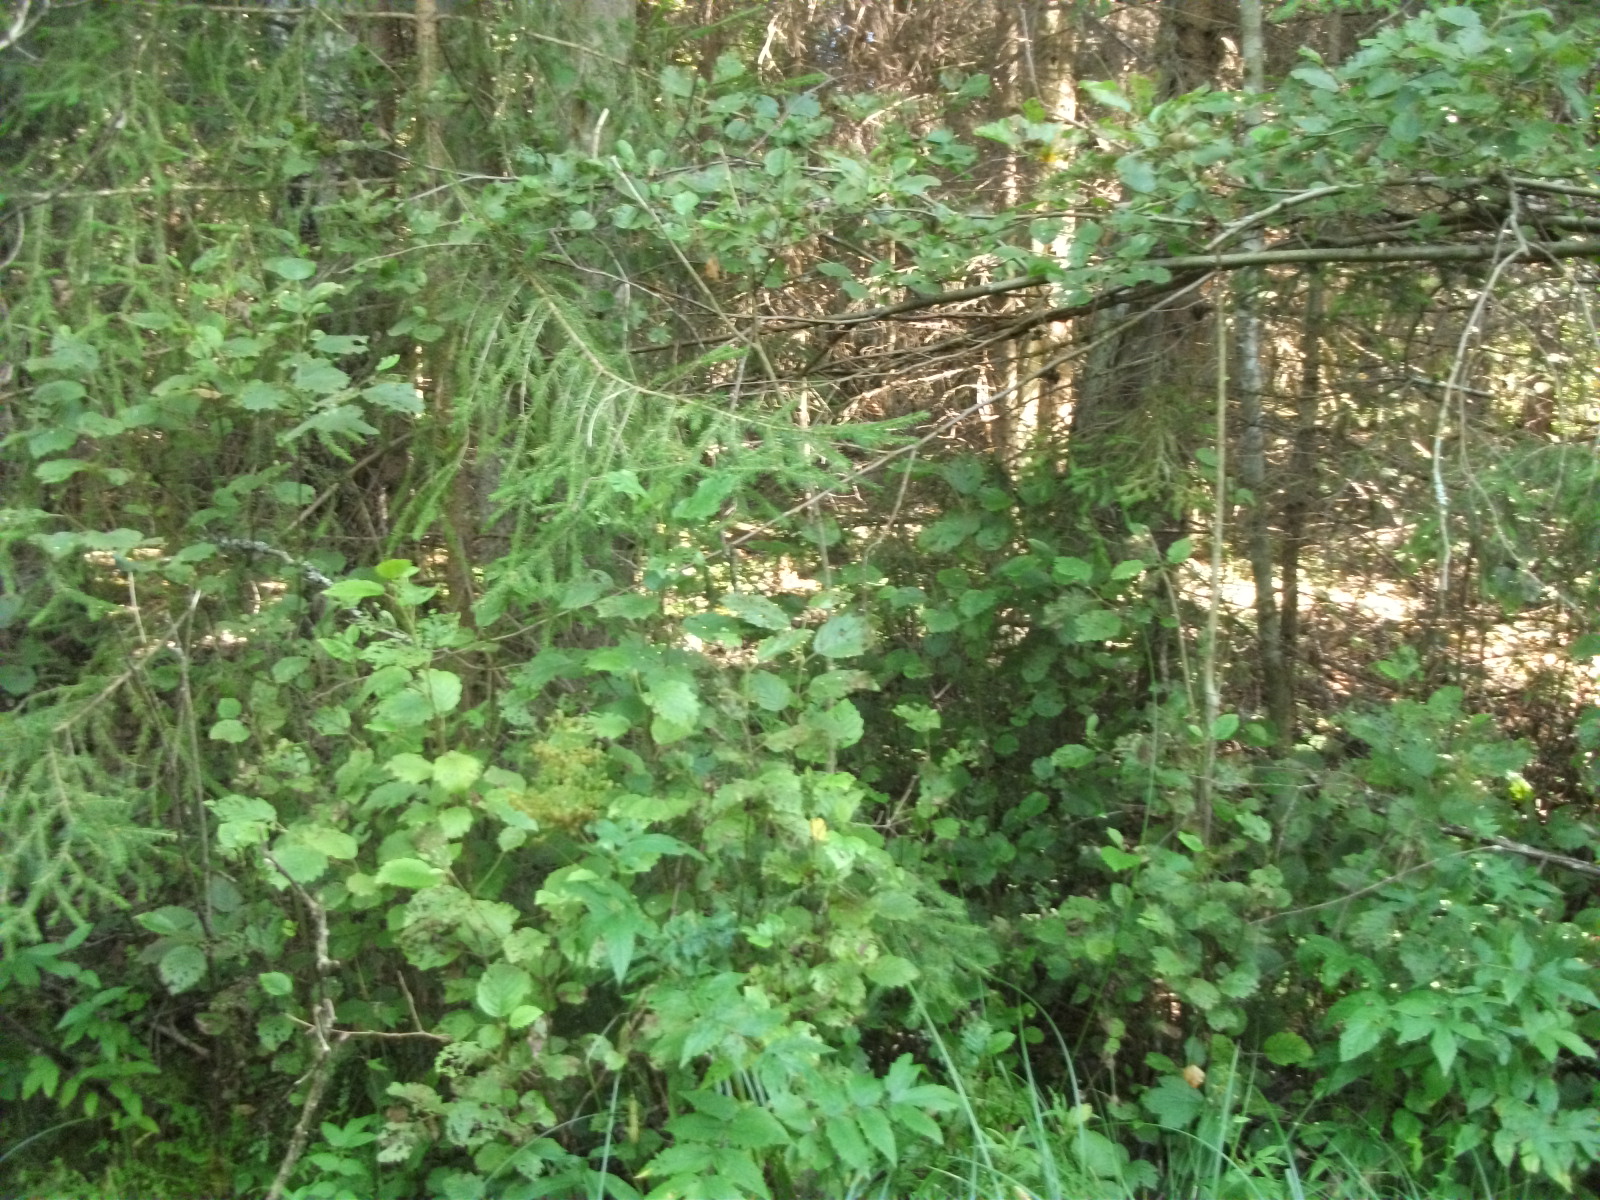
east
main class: Woodland
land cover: Broadleaved woodland
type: mire and swamp forests
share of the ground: 50 - 75 %
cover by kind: broadleaved forest trees 50 %, shrubs 50 %
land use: Forestry
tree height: < 5 m
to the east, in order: Broadleaved woodland; Spruce dominated mixed woodland; Other mixed woodland; Ditches and canals; Broadleaved woodland; Other mixed woodland; Spruce dominated mixed woodland
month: August
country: LV
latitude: 56.6458
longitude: 26.1348
